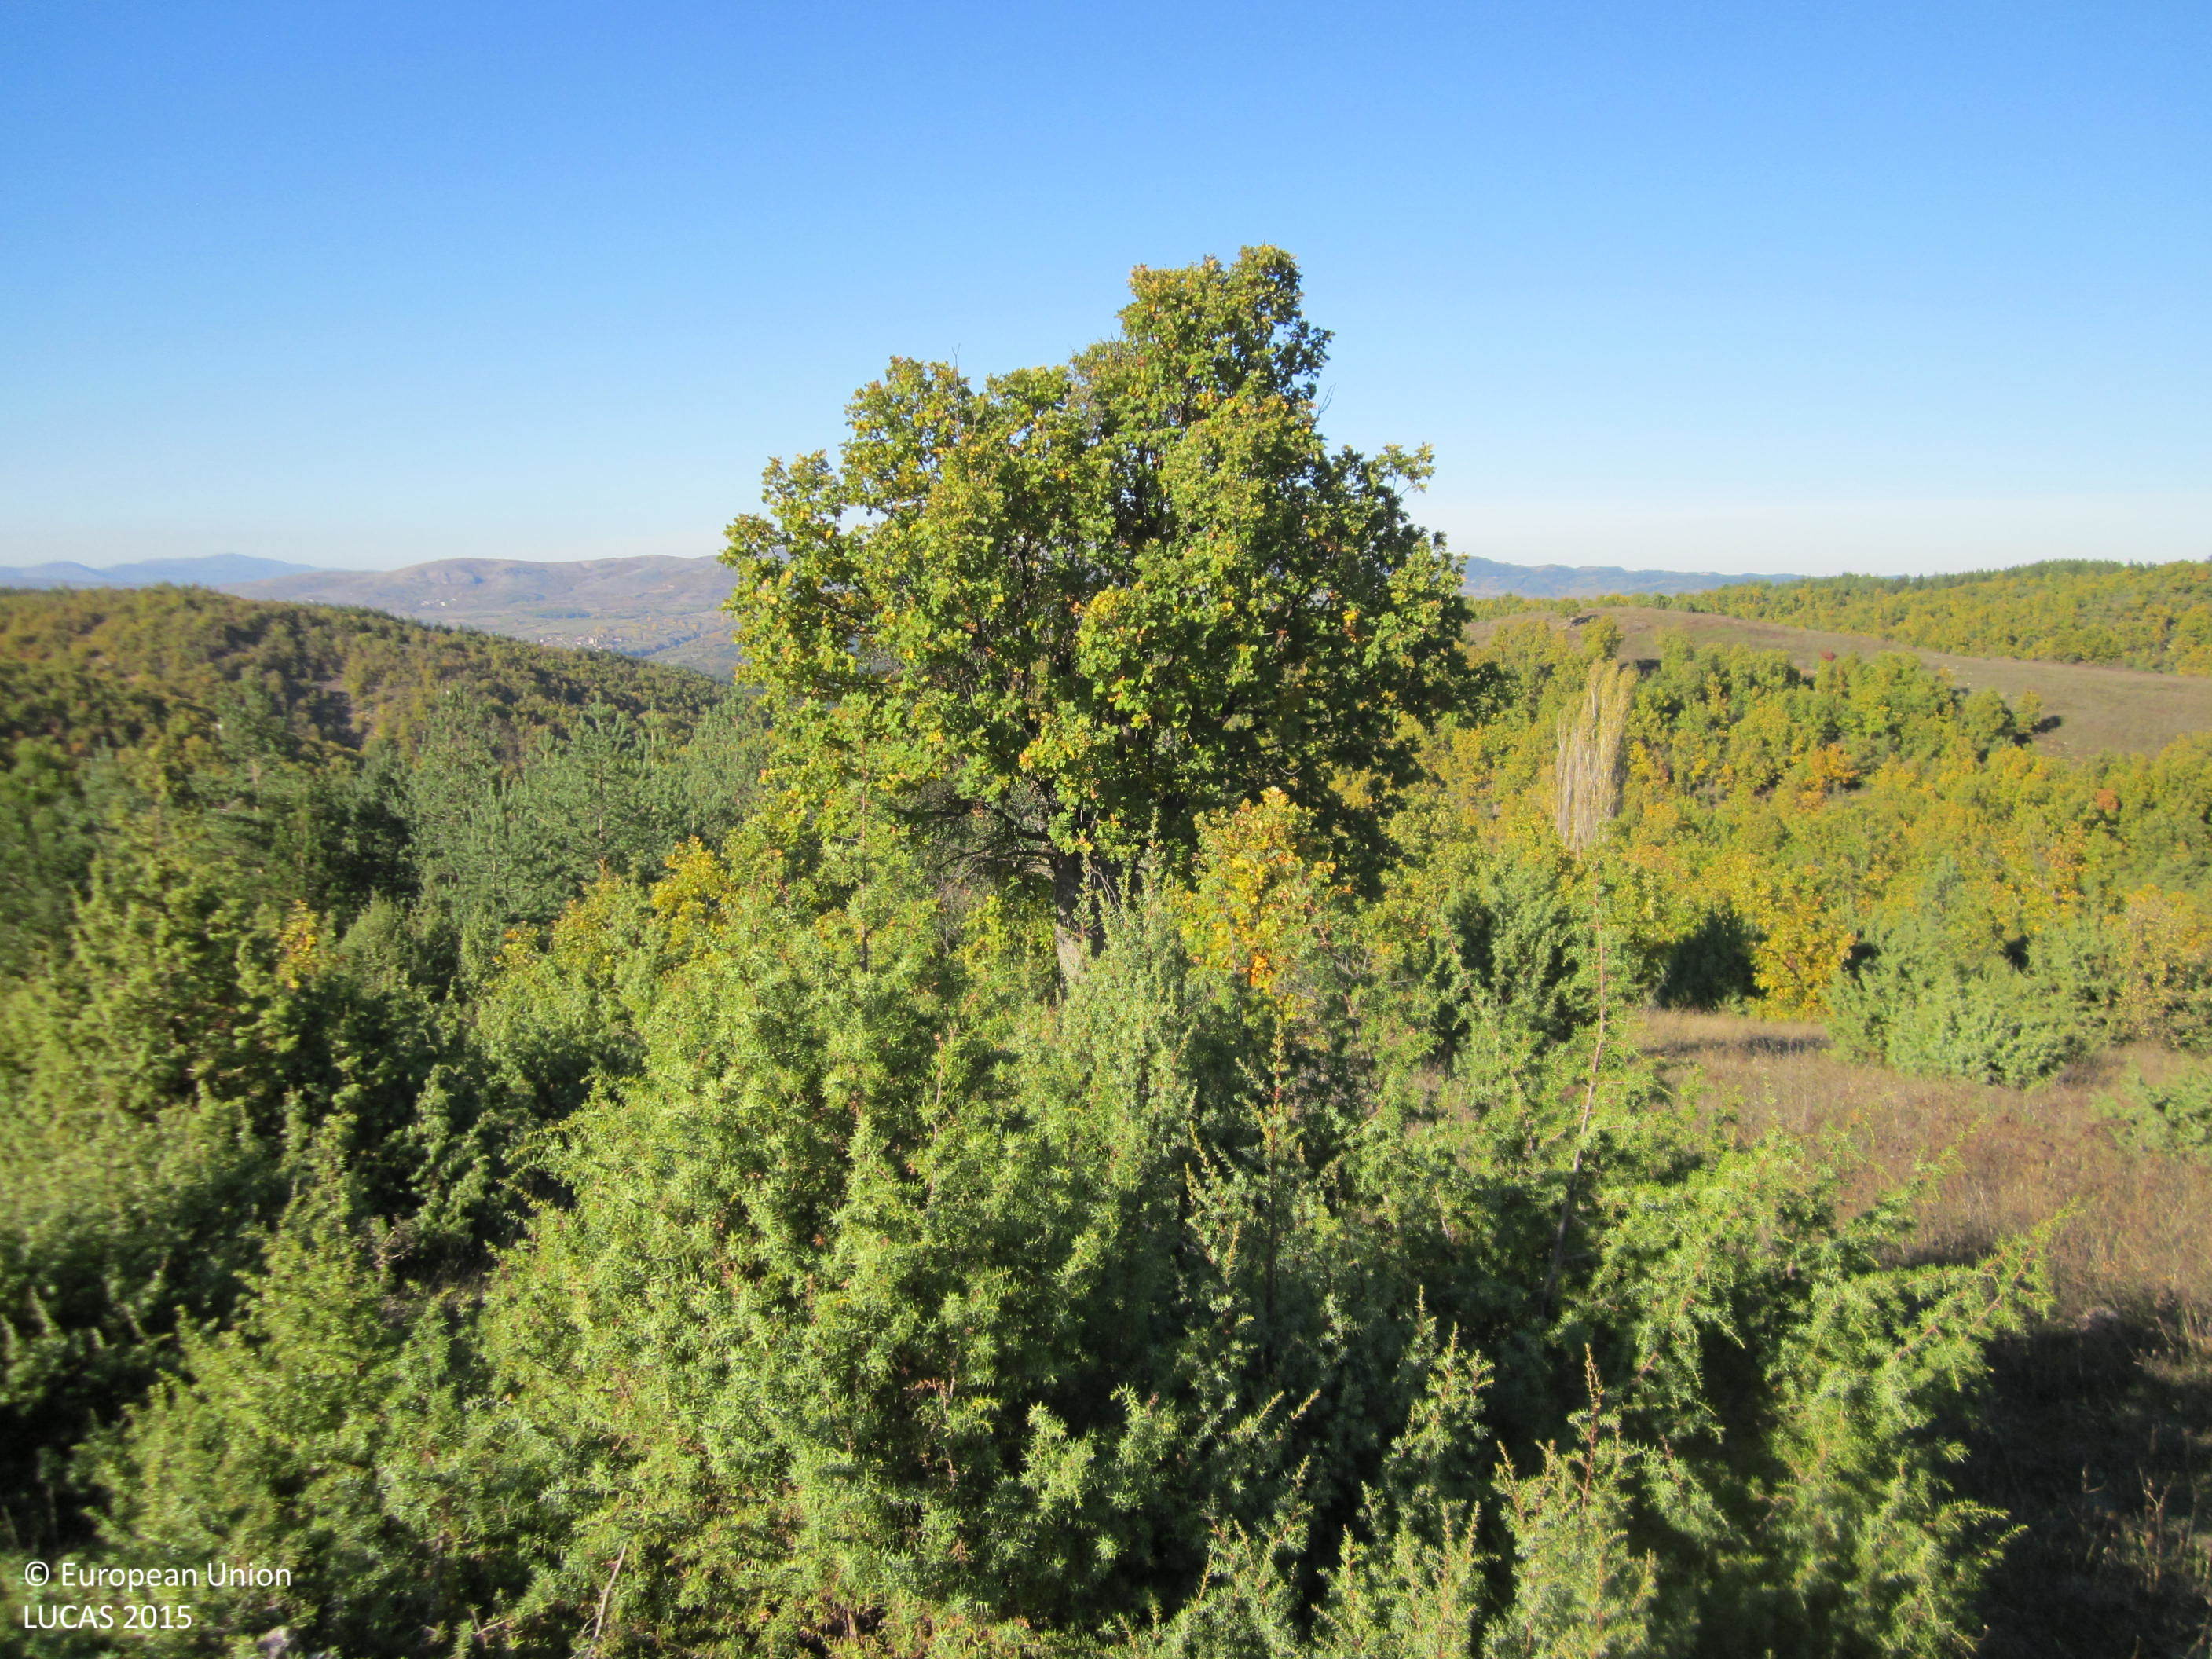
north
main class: Woodland
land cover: Other coniferous woodland
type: hemiboreal forest and nemoral coniferous forest and mixed broadleaved-coniferous forest
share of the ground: 50 - 75 %
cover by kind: coniferous forest trees 60 %, herbaceous plants 35 %, broadleaved forest trees 5 %
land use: Agriculture (excluding fallow land and kitchen gardens)
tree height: < 5 m
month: November
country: BG
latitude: 41.4135
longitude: 25.7455
